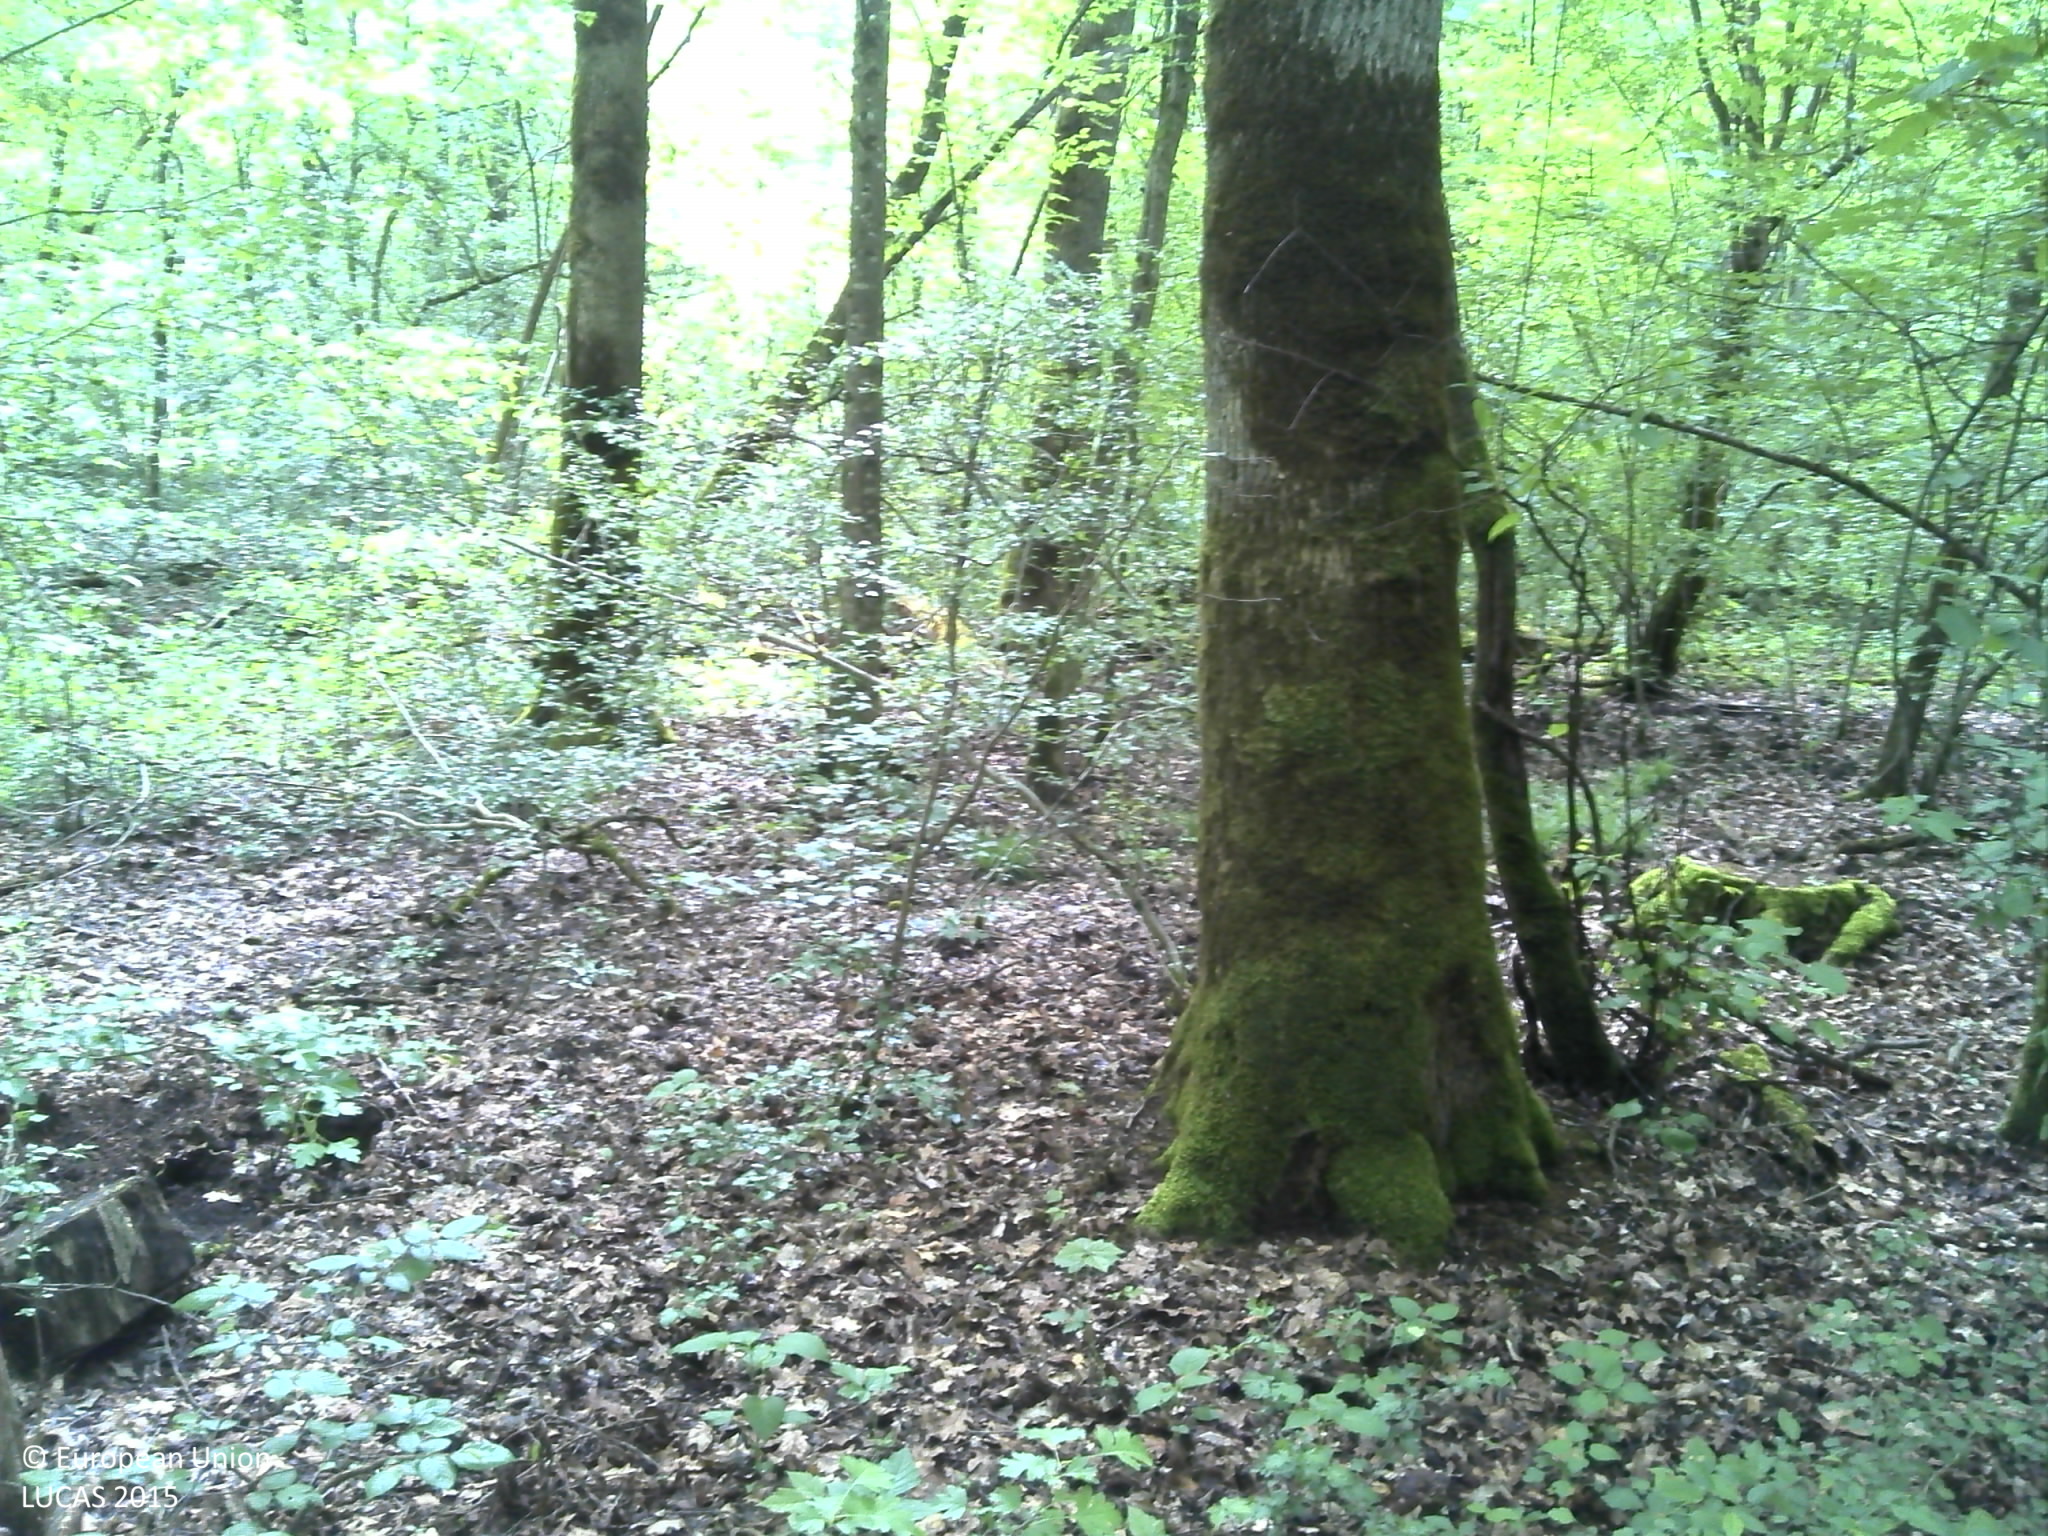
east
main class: Woodland
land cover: Broadleaved woodland
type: mesophytic deciduous forest
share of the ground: > 75 %
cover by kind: broadleaved forest trees 100 %
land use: Forestry
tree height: > 5 m
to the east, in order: Broadleaved woodland; Rivers and streams; Fences; Shrubland with sparse tree cover
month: May
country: HR
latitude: 45.0347
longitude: 18.9304
